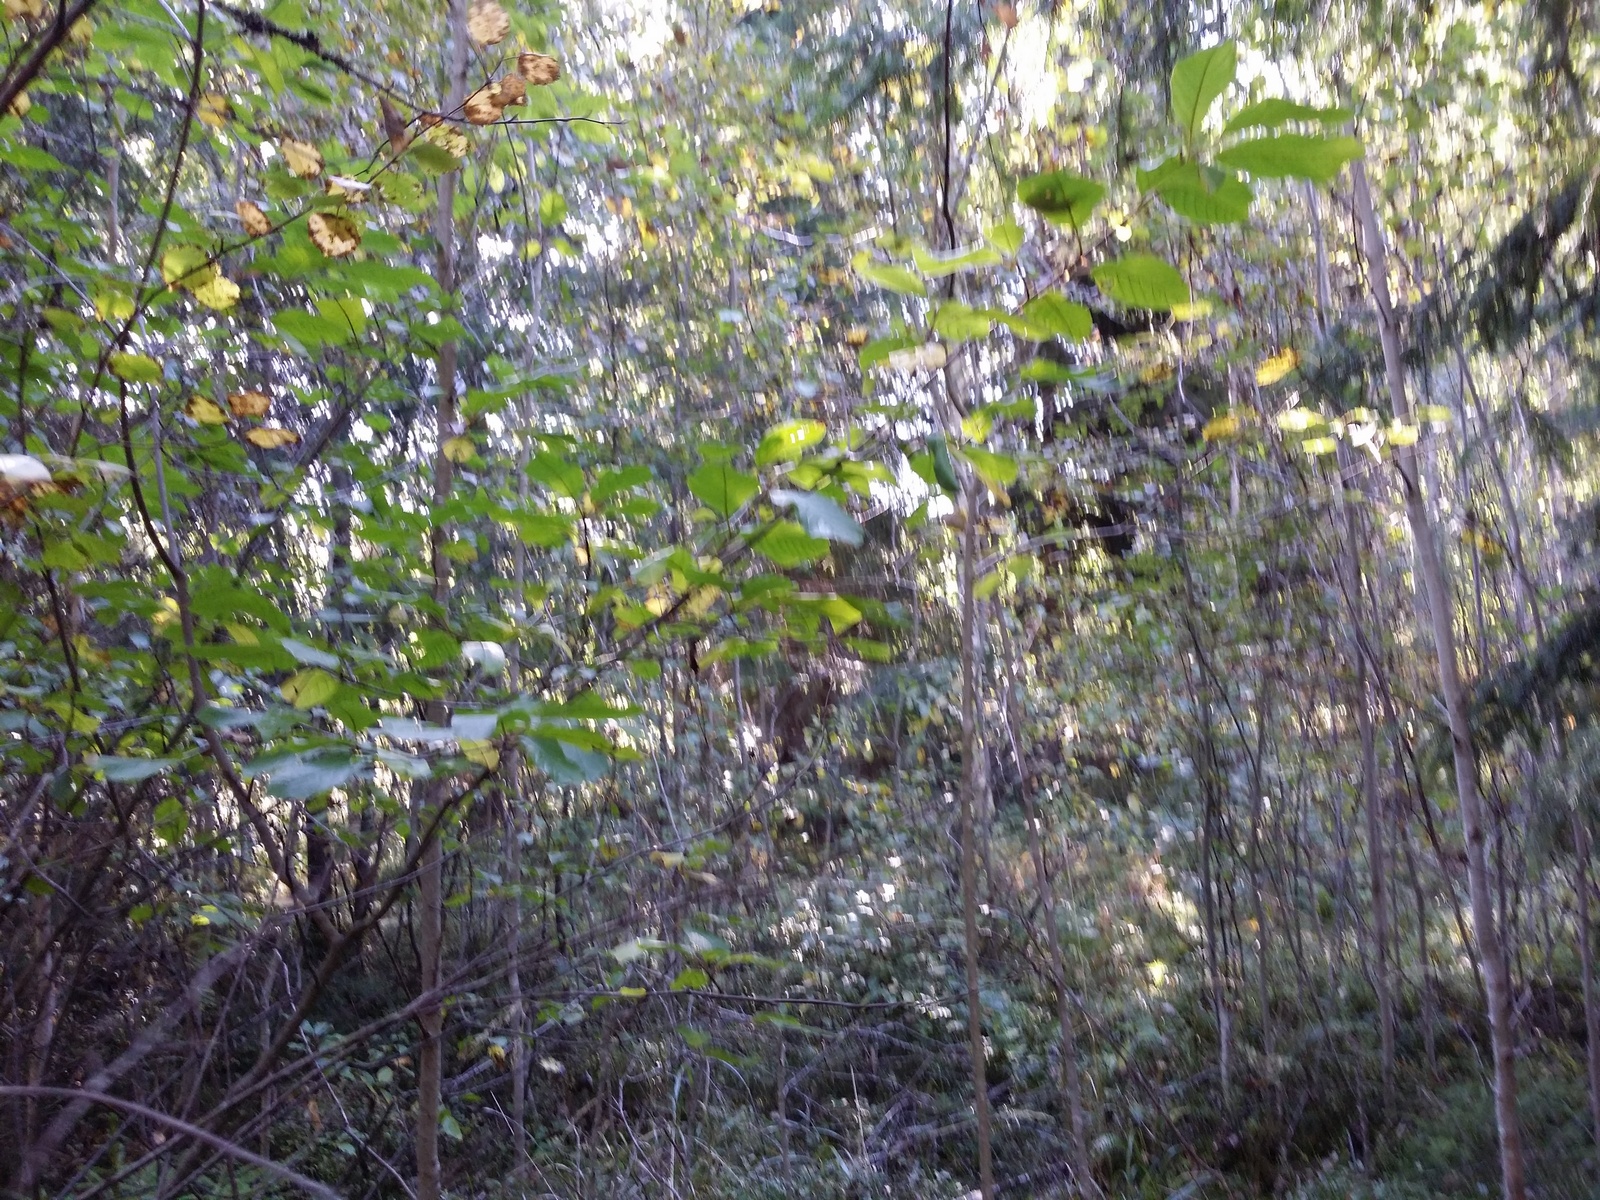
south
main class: Woodland
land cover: Spruce dominated mixed woodland
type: hemiboreal forest and nemoral coniferous forest and mixed broadleaved-coniferous forest
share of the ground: > 75 %
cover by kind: coniferous forest trees 50 %, broadleaved forest trees 35 %, lichens and mosses 10 %, herbaceous plants 5 %
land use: Forestry
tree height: > 5 m
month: September
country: LV
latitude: 57.1905
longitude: 27.6035
